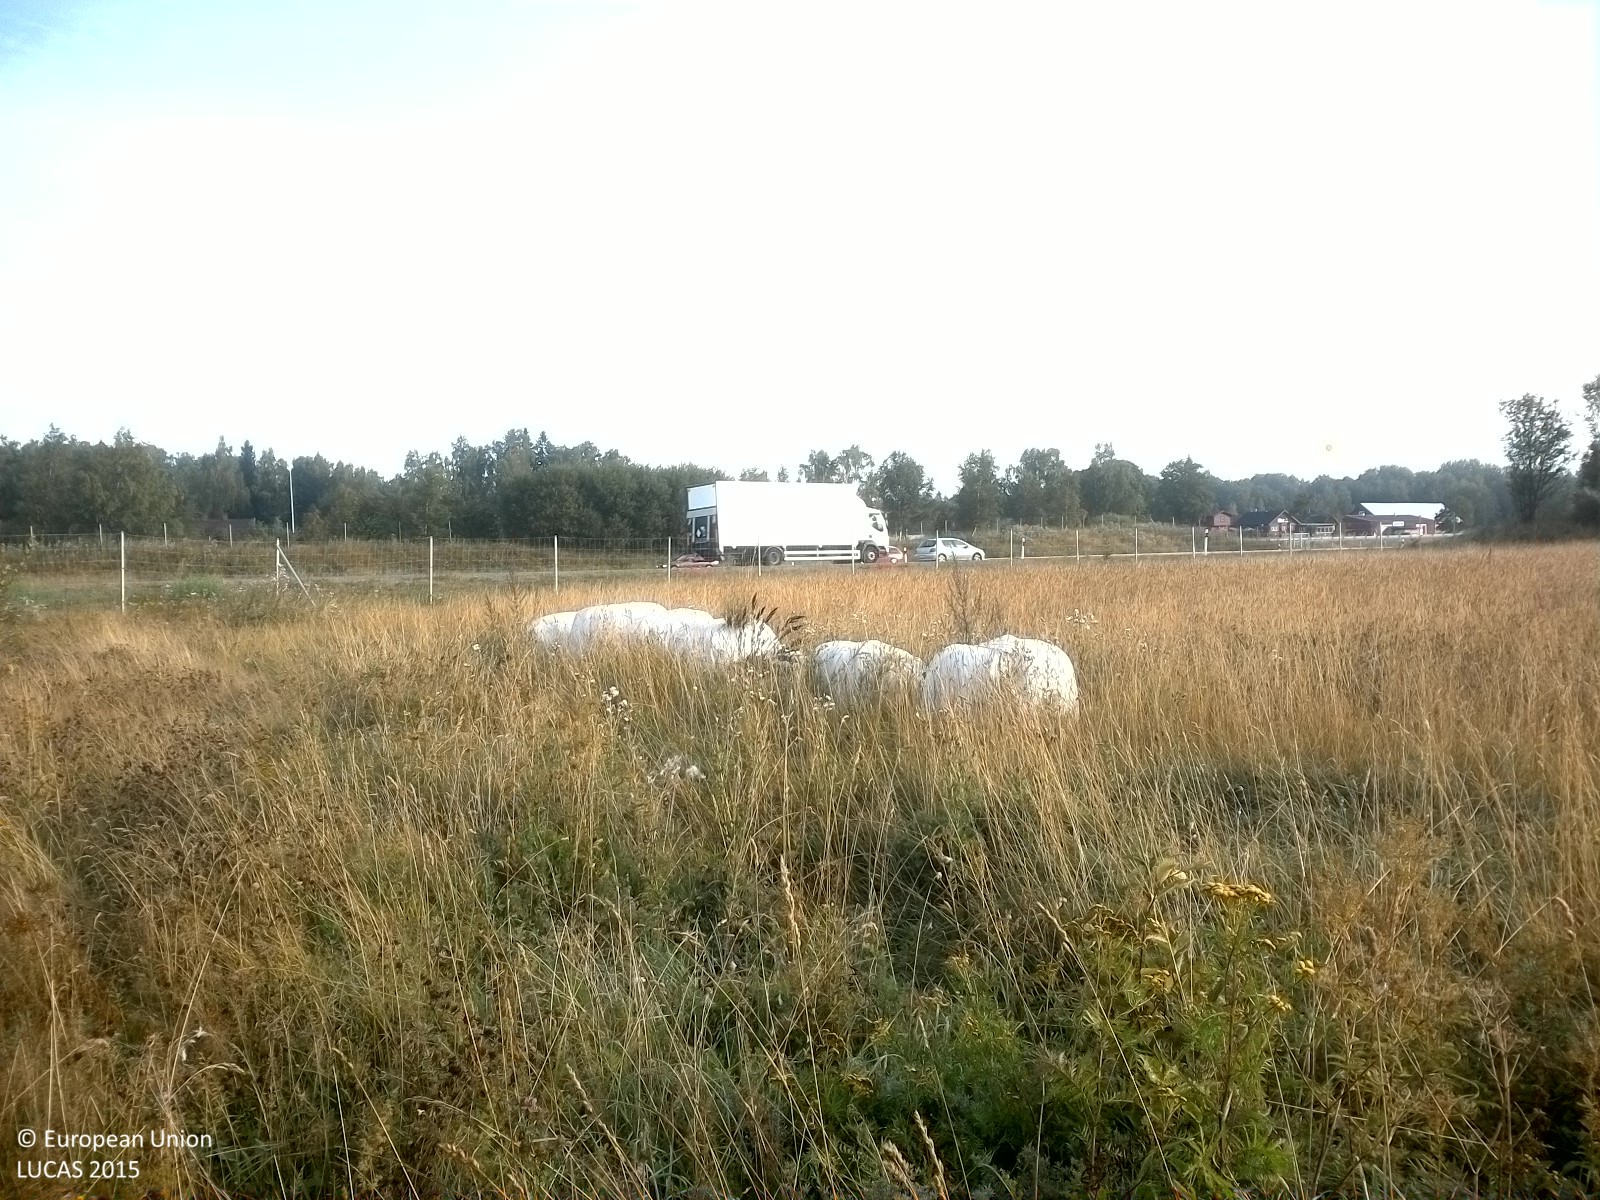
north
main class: Grassland
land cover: Spontaneously vegetated surfaces
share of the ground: > 75 %
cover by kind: herbaceous plants 100 %
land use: Fallow land
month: August
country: SE
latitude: 59.3324
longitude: 15.5285
